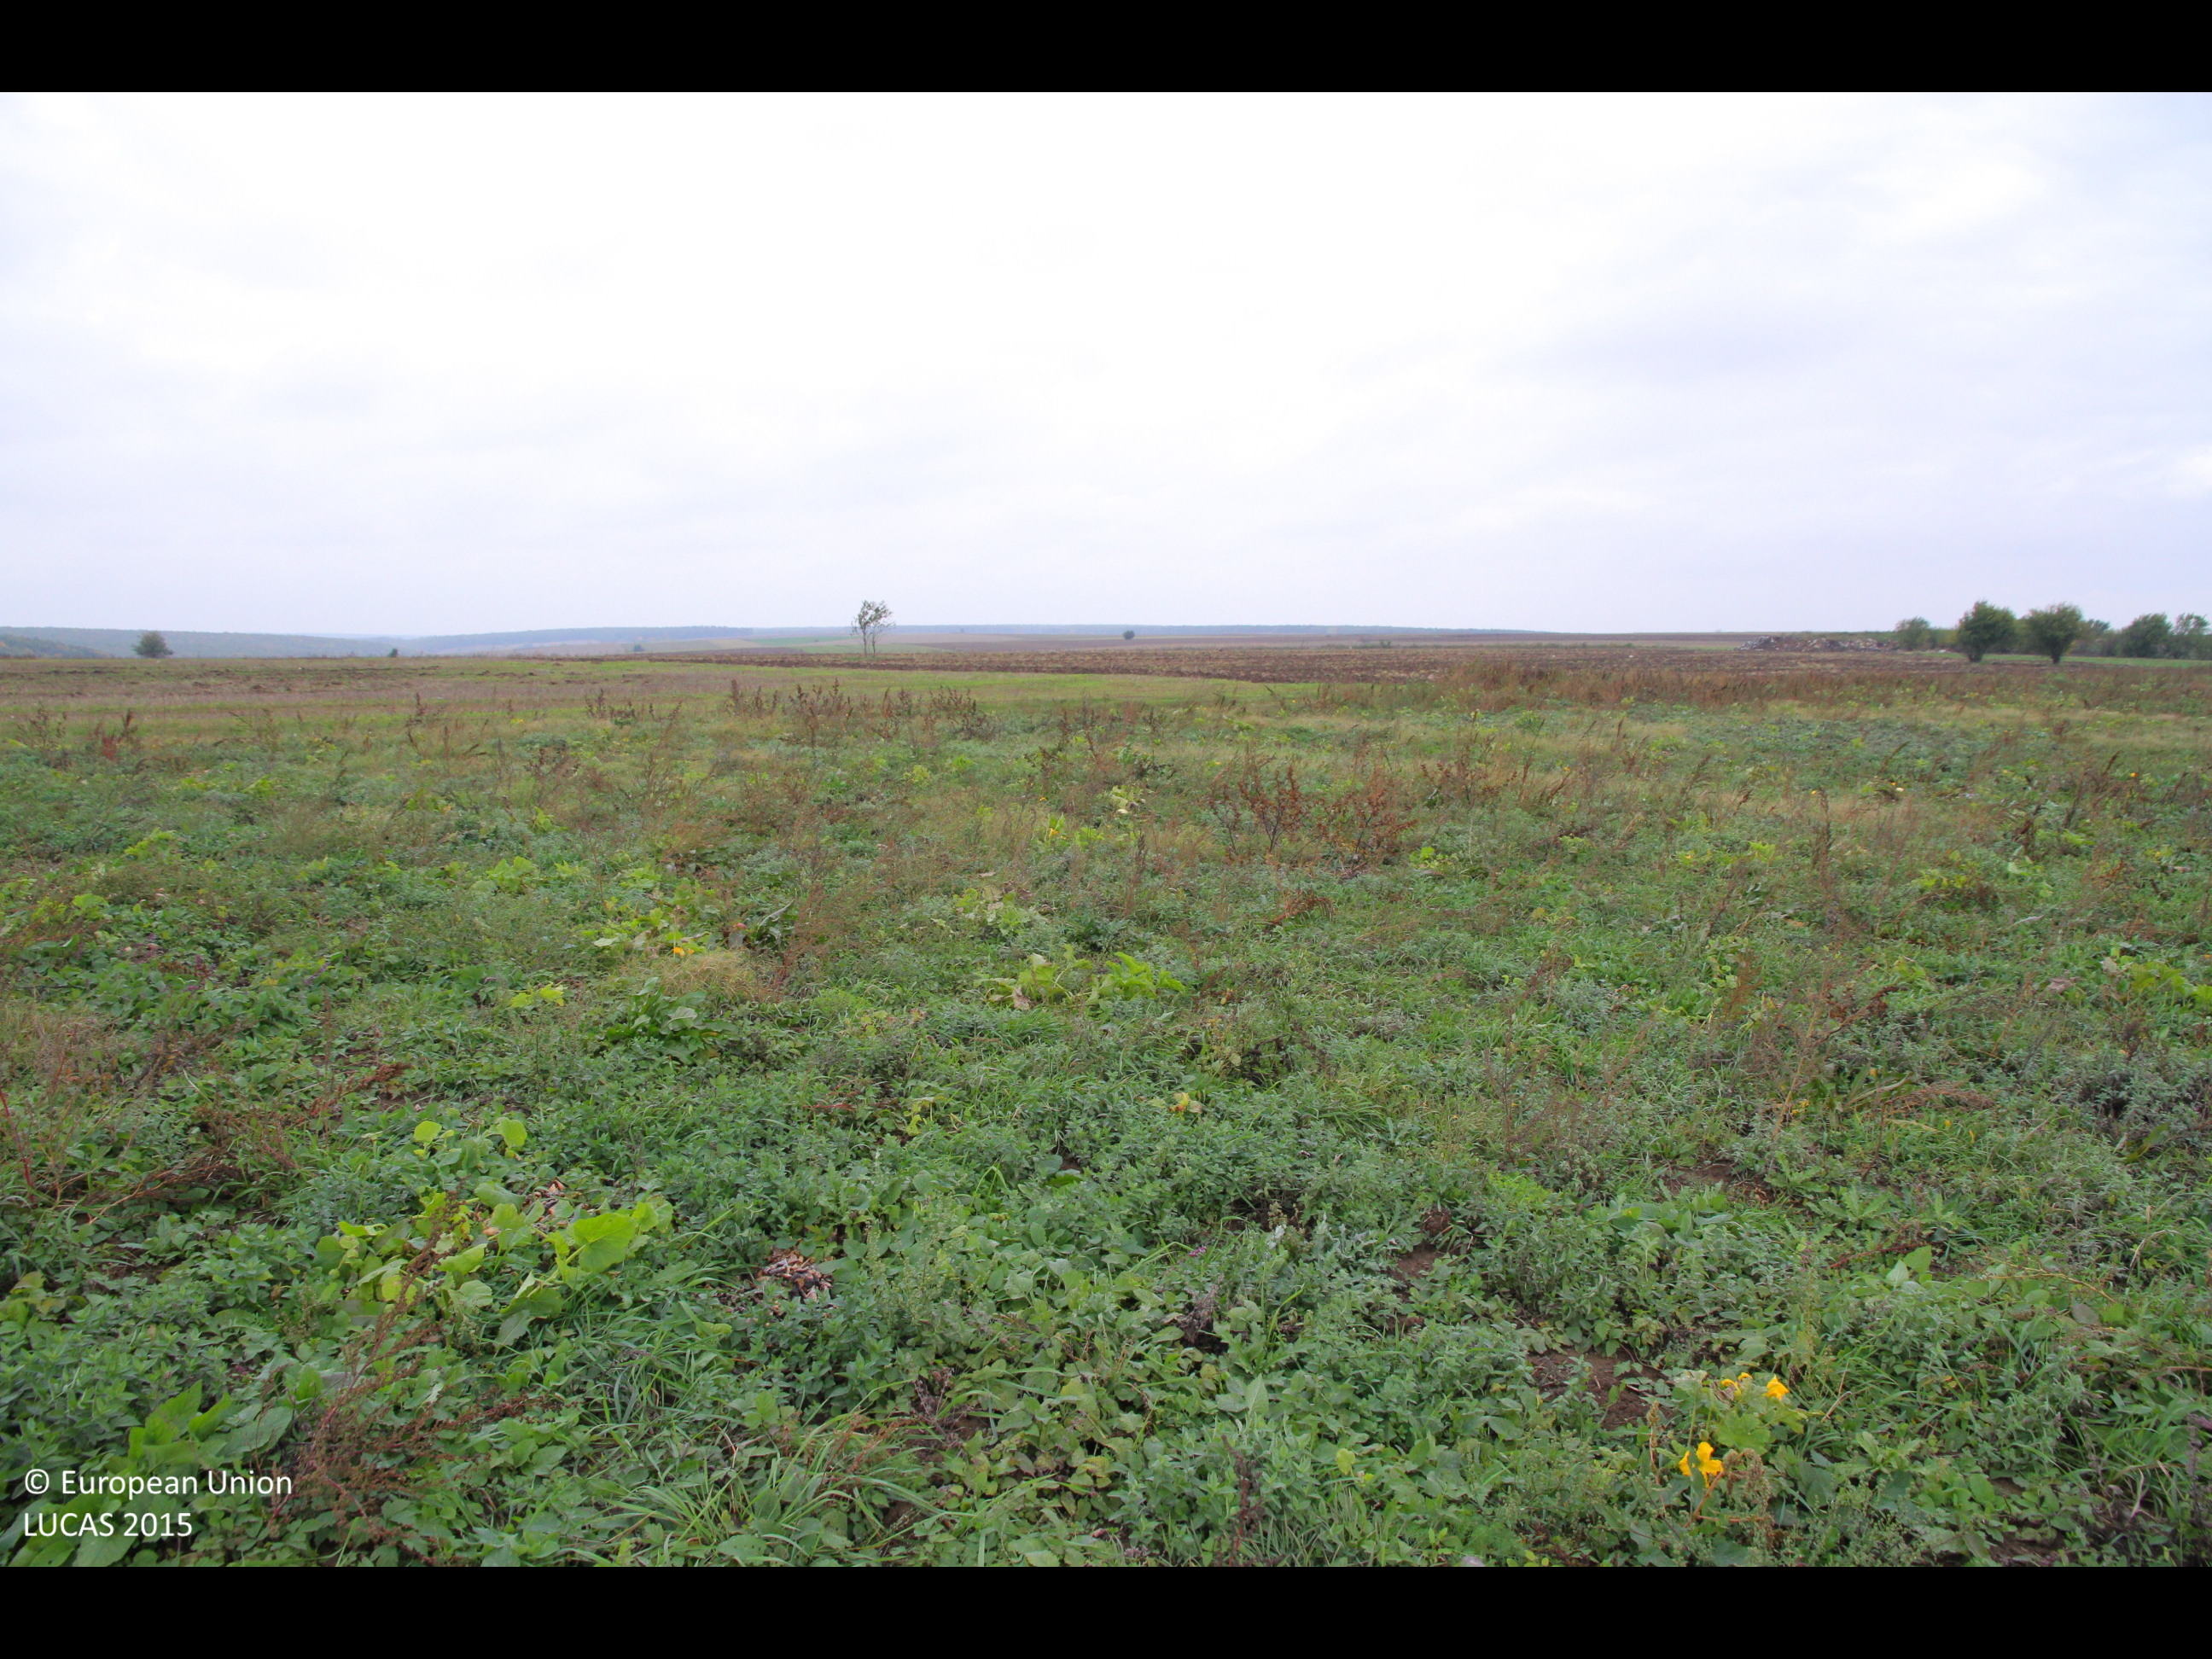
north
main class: Cropland
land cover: Other fresh vegetables
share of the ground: 10 - 25 %
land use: Agriculture (excluding fallow land and kitchen gardens)
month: October
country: BG
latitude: 43.5434
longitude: 26.8849
